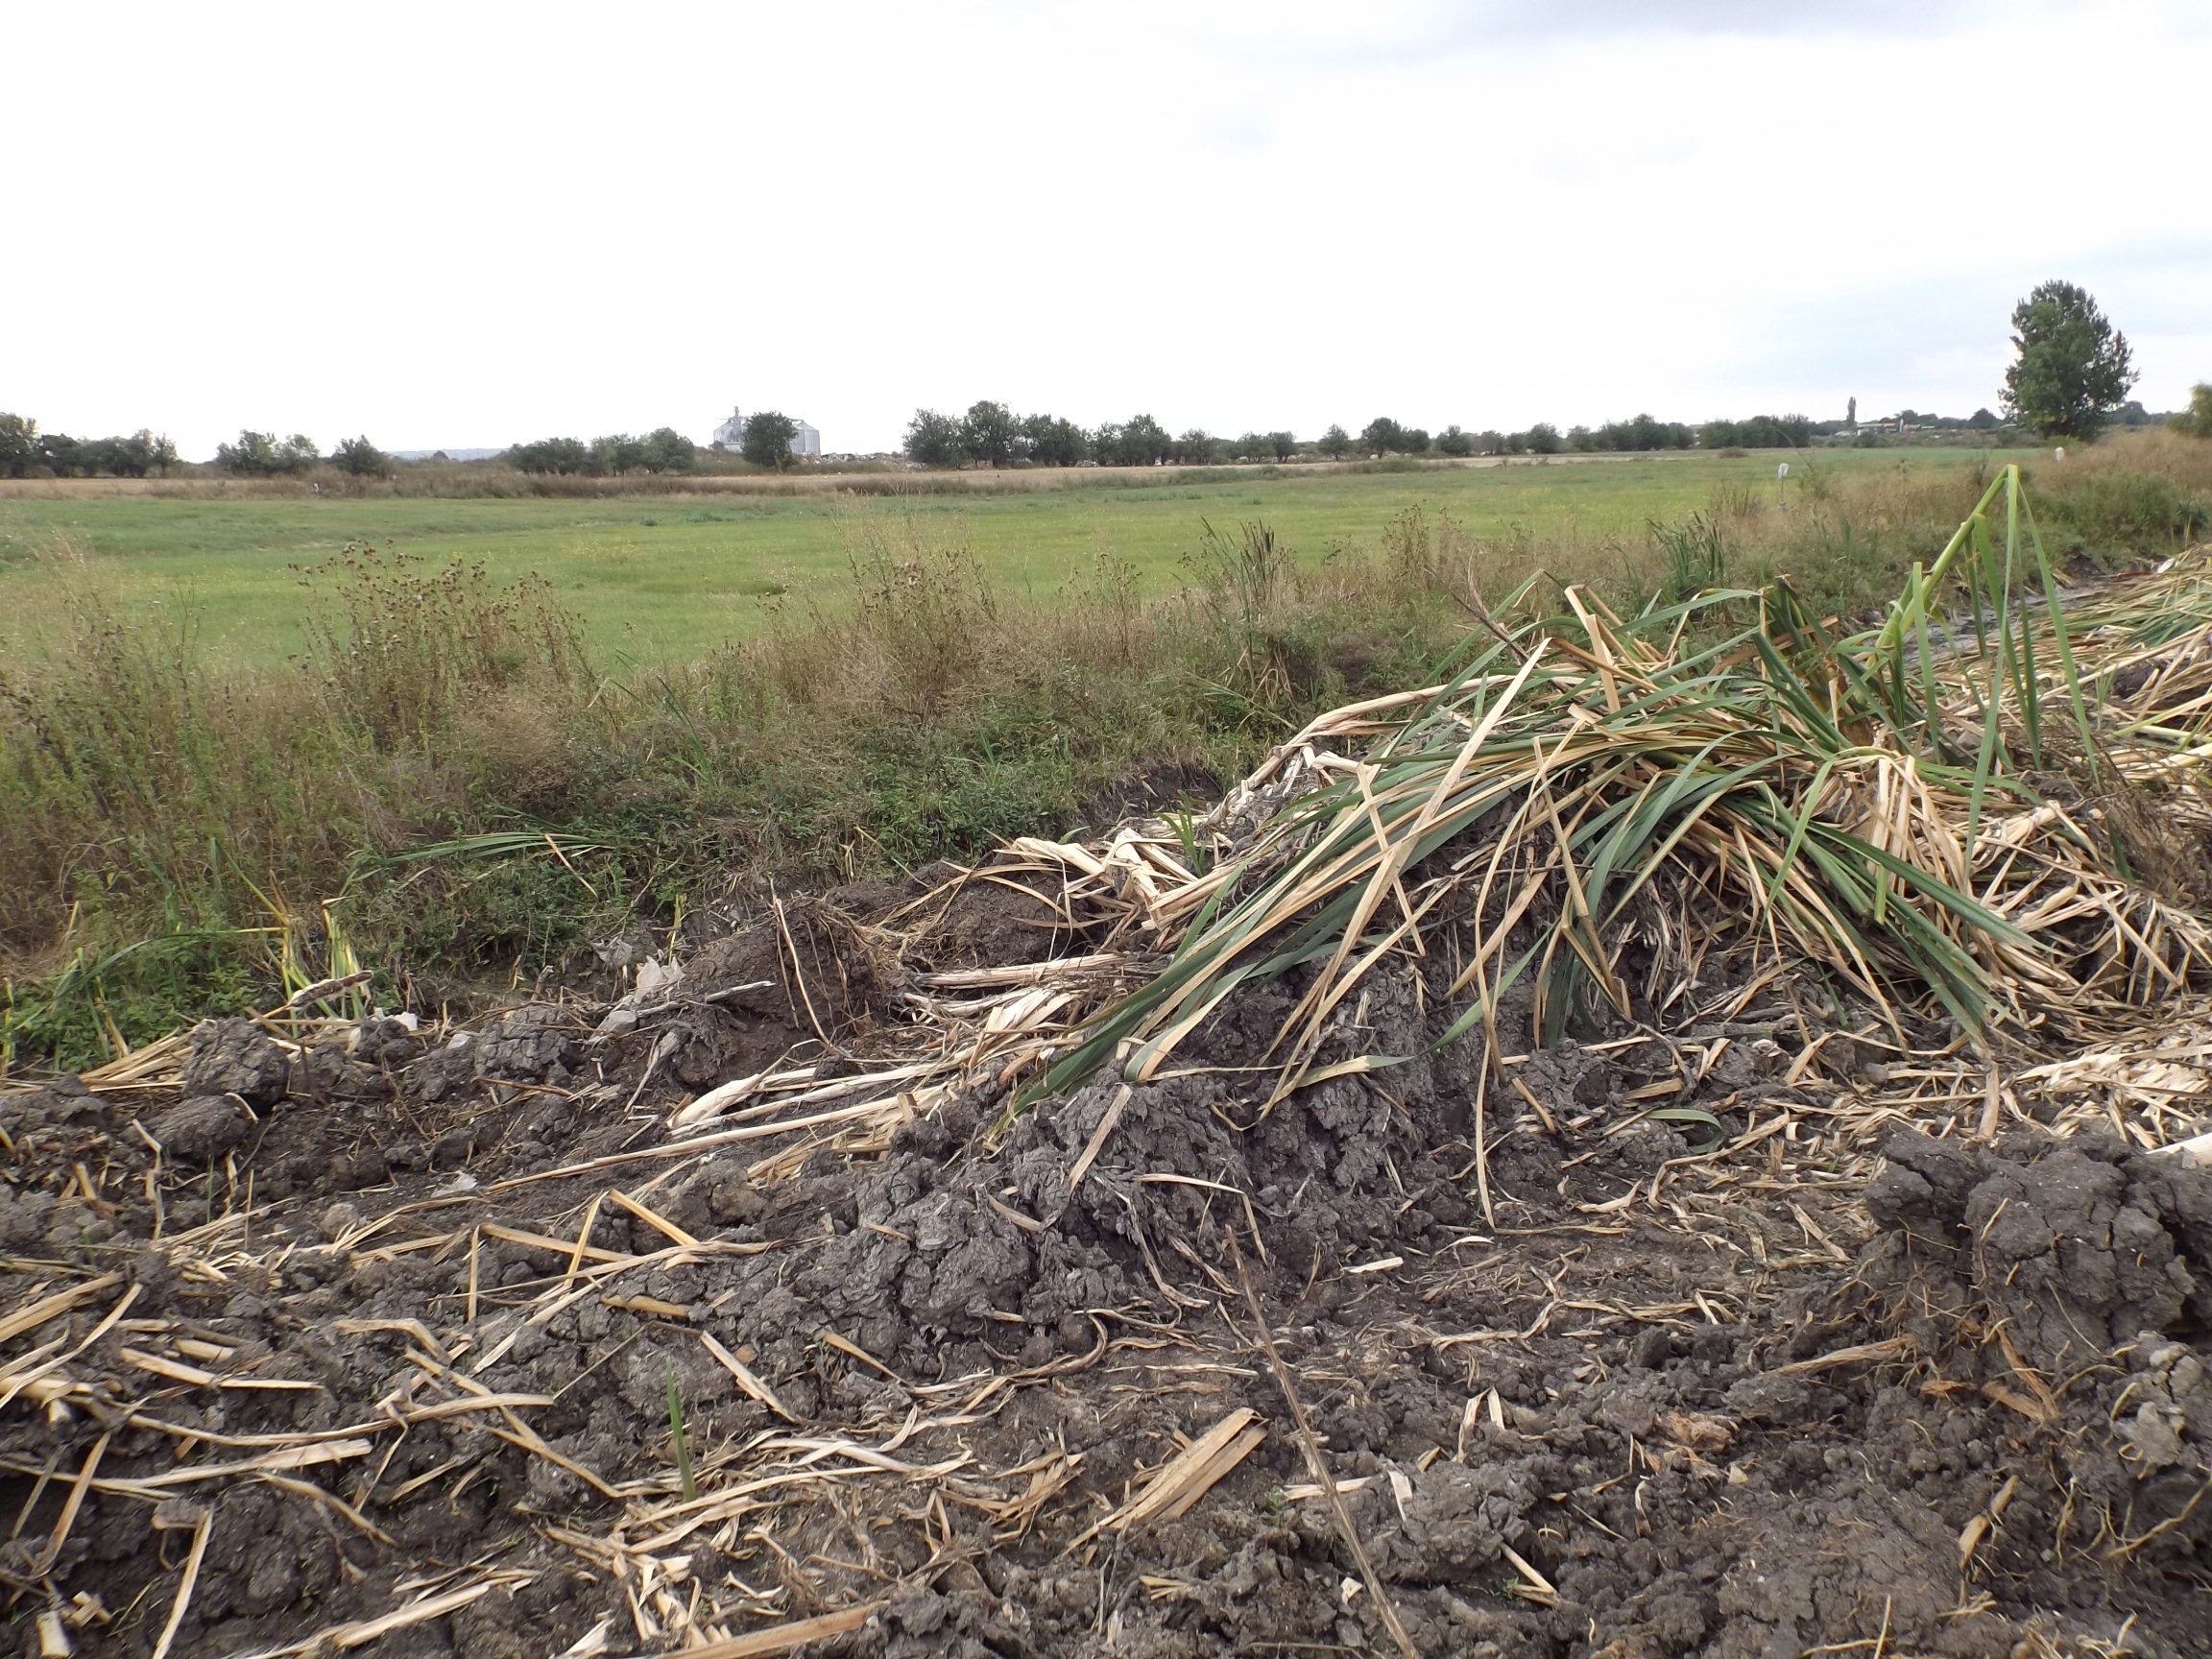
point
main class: Grassland
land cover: Grassland without tree/shrub cover
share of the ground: 10 - 25 %
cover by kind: herbaceous plants 100 %
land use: Agriculture (excluding fallow land and kitchen gardens)
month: August
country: BG
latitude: 43.3048
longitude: 27.4224
